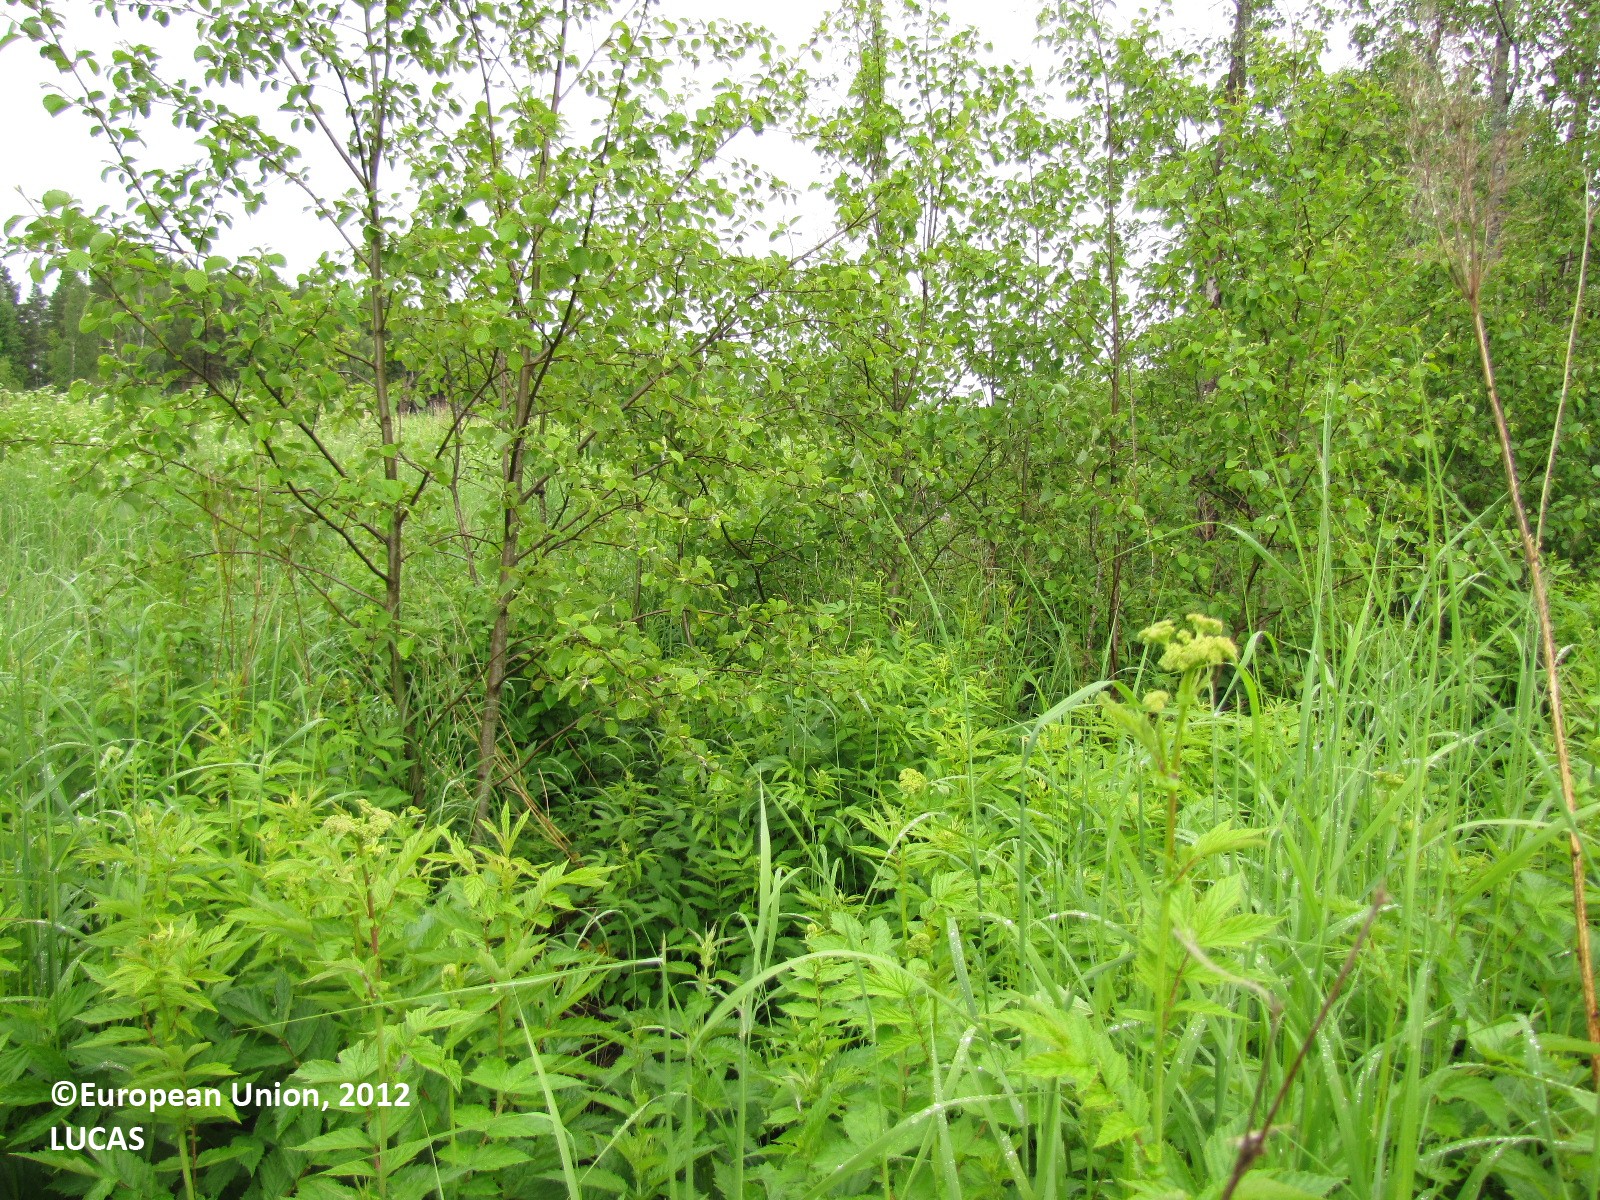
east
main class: Shrubland
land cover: Shrubland with sparse tree cover
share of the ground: 25 - 50 %
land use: Agriculture (excluding fallow land and kitchen gardens)
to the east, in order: Shrubland with sparse tree cover; Ditches and canals; Temporary grasslands; Dry pulses; Grass margins; Ditches and canals; Grass margins; Oats; Grass margins; Ditches and canals; Grass margins; Tracks; Grass margins; Temporary grasslands; Ditches and canals; Abandoned hedges; Spruce dominated mixed woodland
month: June
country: FI
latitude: 61.2964
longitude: 24.3382
